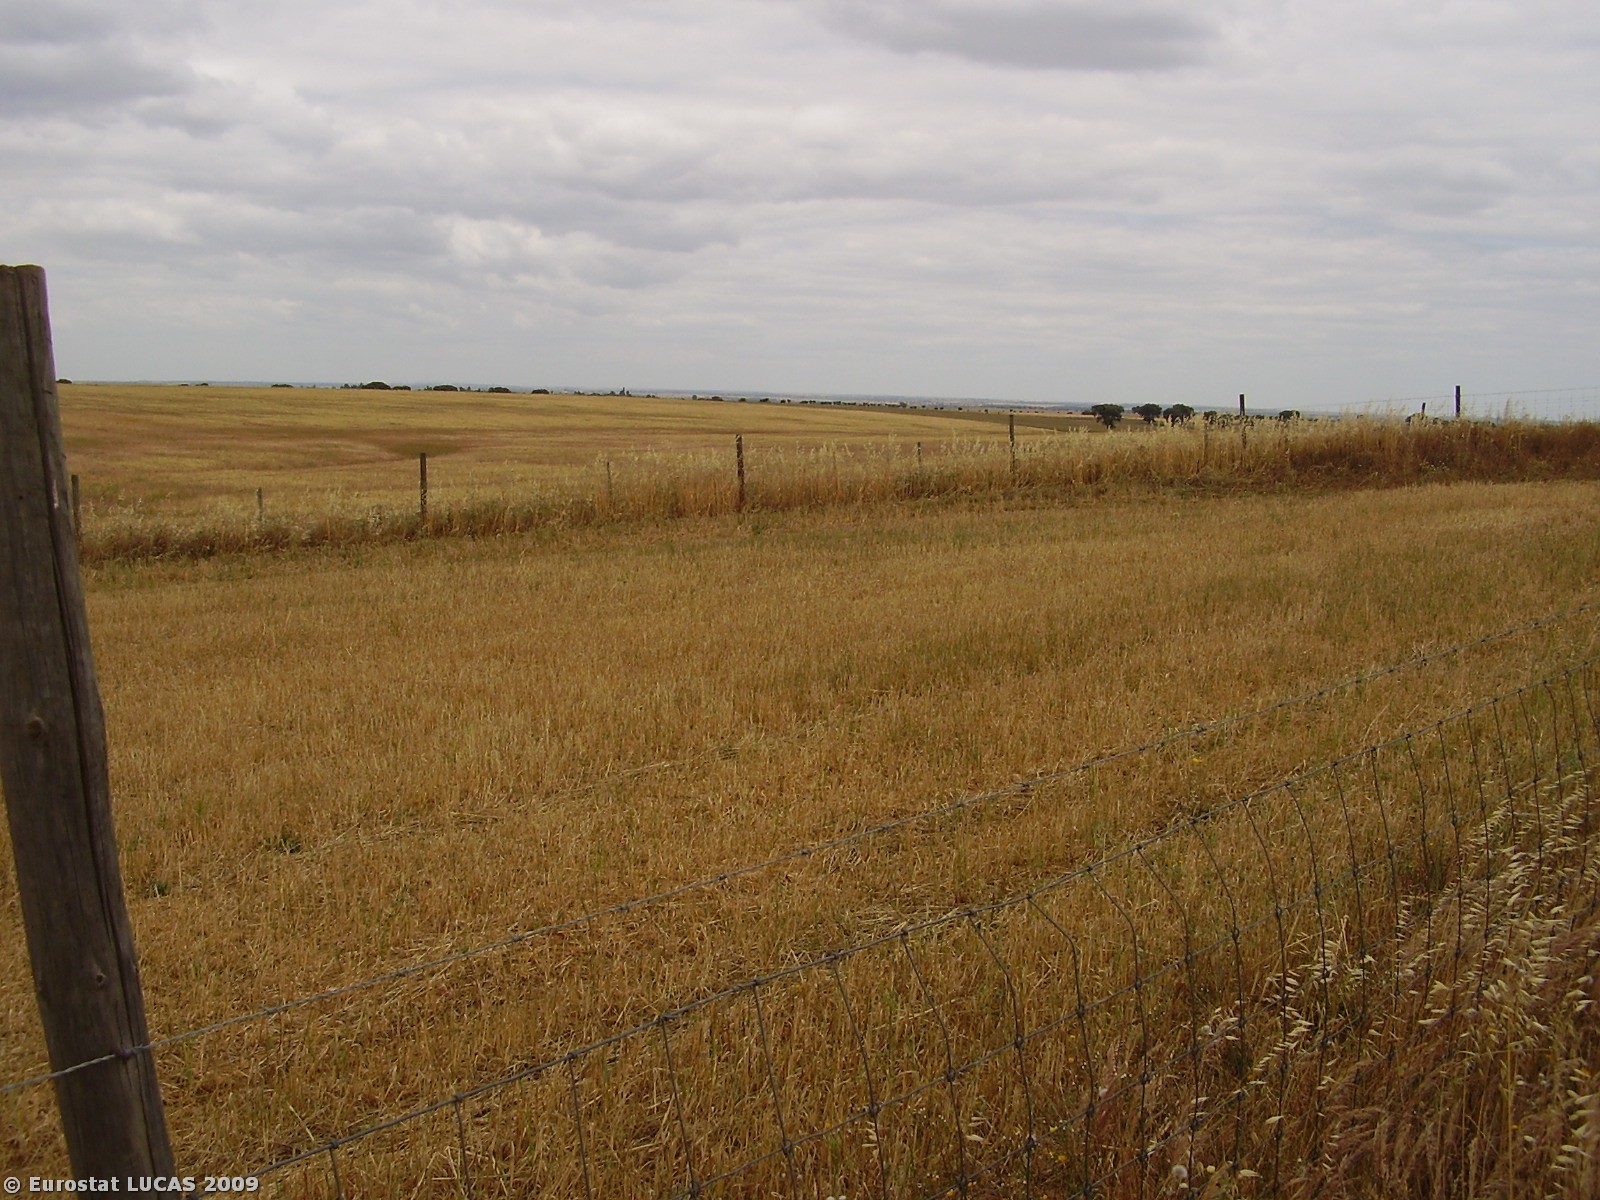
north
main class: Grassland
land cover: Grassland without tree/shrub cover
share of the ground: > 75 %
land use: Agriculture (excluding fallow land and kitchen gardens)
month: May
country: PT
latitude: 37.7596
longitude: -7.8780
